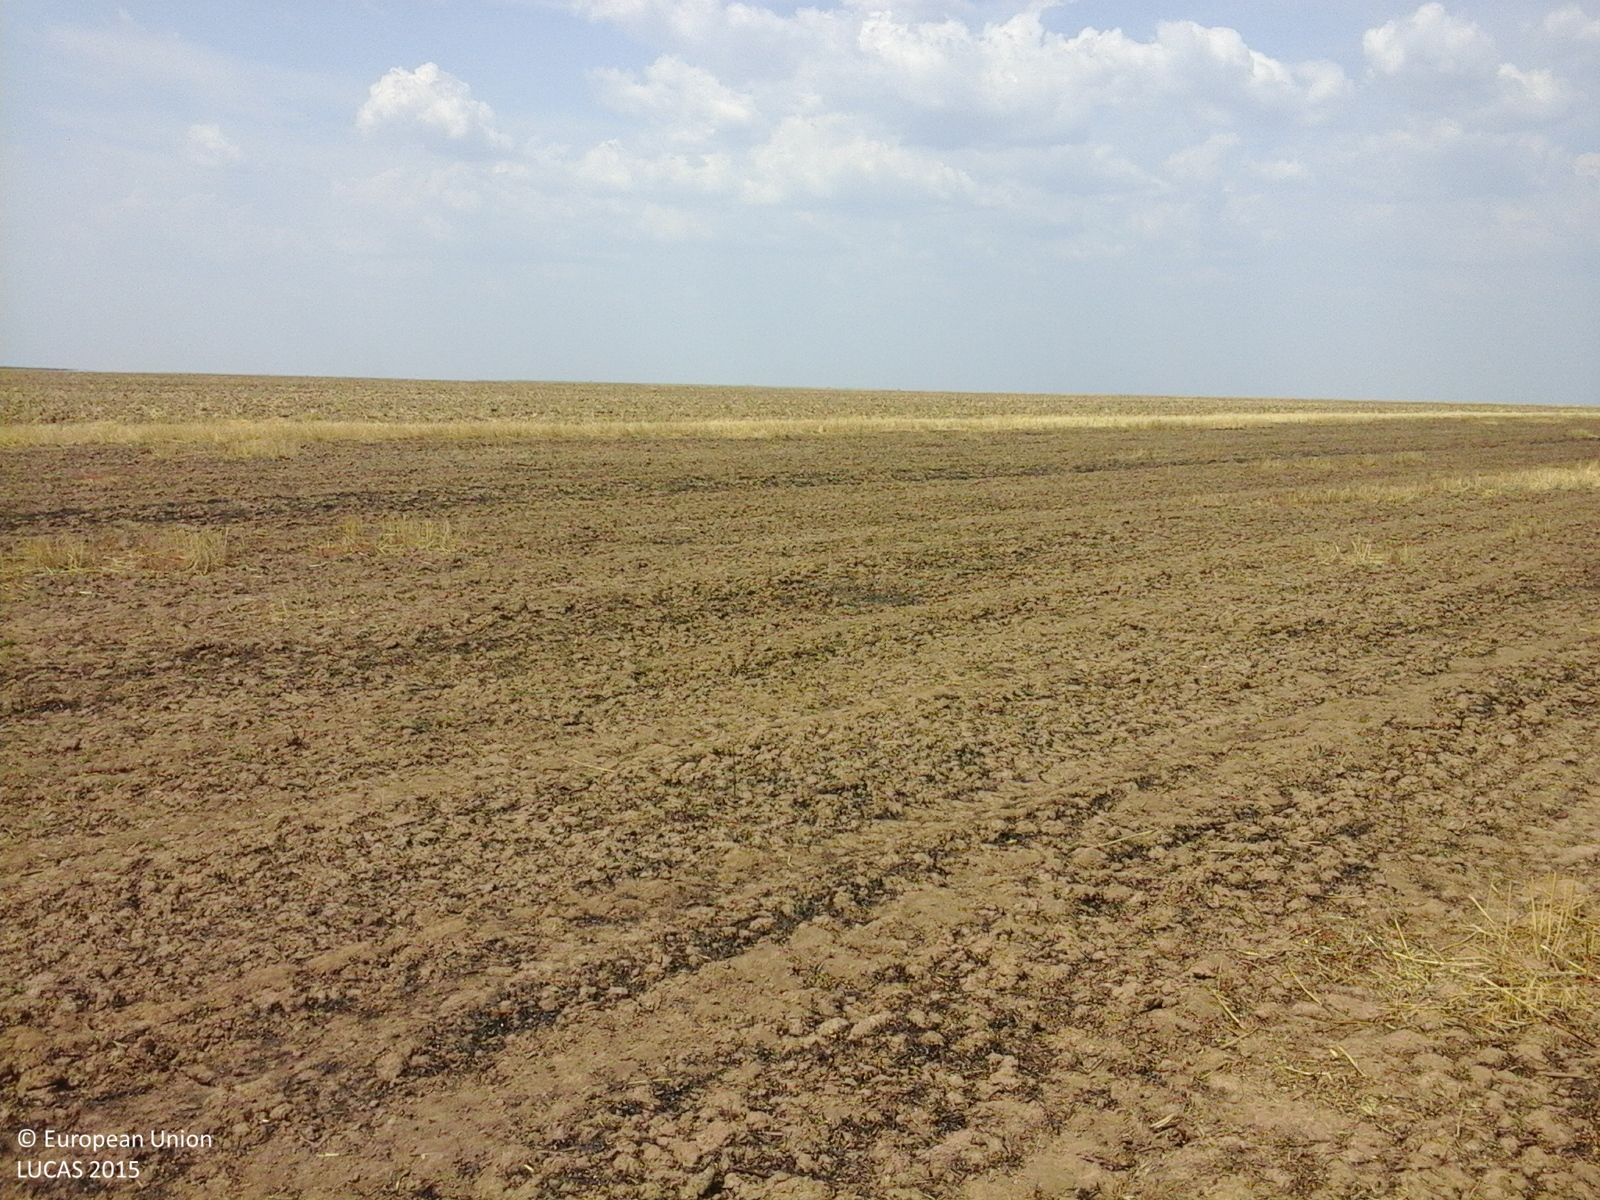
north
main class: Cropland
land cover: Common wheat
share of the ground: < 10 %
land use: Agriculture (excluding fallow land and kitchen gardens)
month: August
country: RO
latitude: 44.2599
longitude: 23.1349
